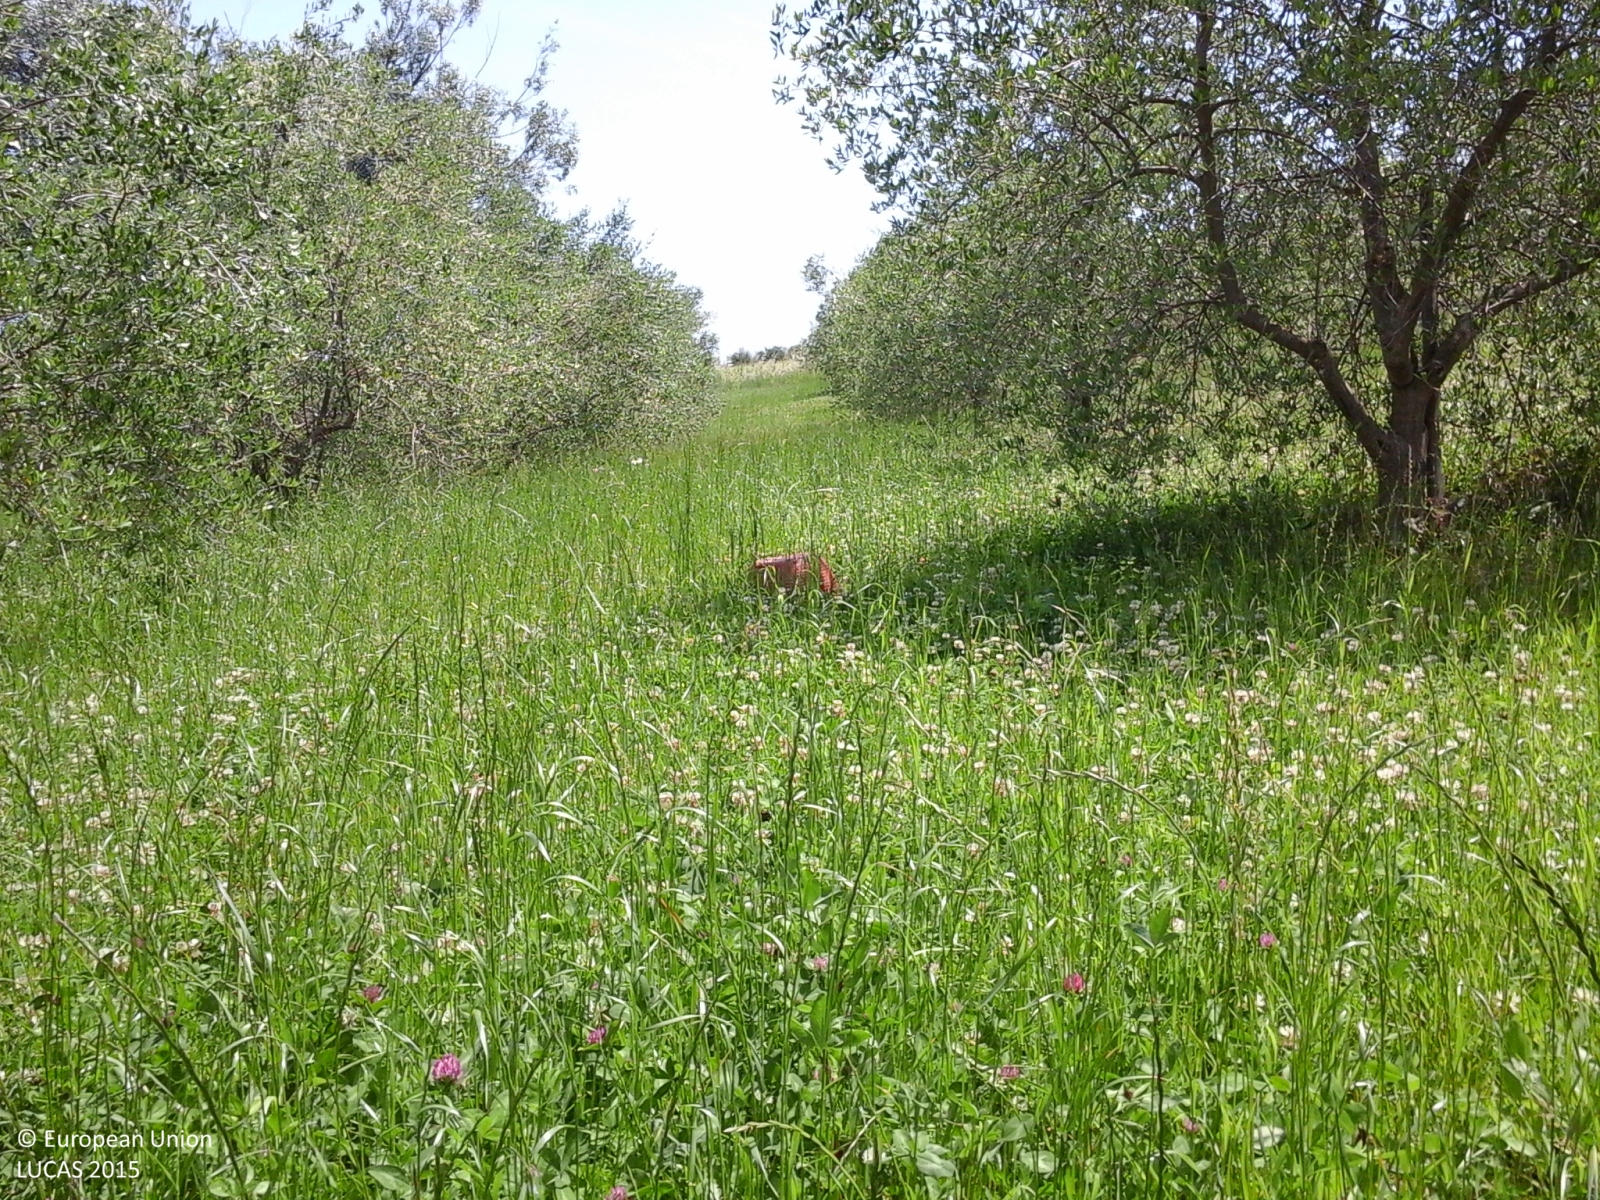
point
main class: Cropland
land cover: Olive groves
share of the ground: > 75 %
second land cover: Spontaneously vegetated surfaces
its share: > 75 %
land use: Agriculture (excluding fallow land and kitchen gardens)
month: May
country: IT
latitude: 44.0515
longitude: 12.4283
